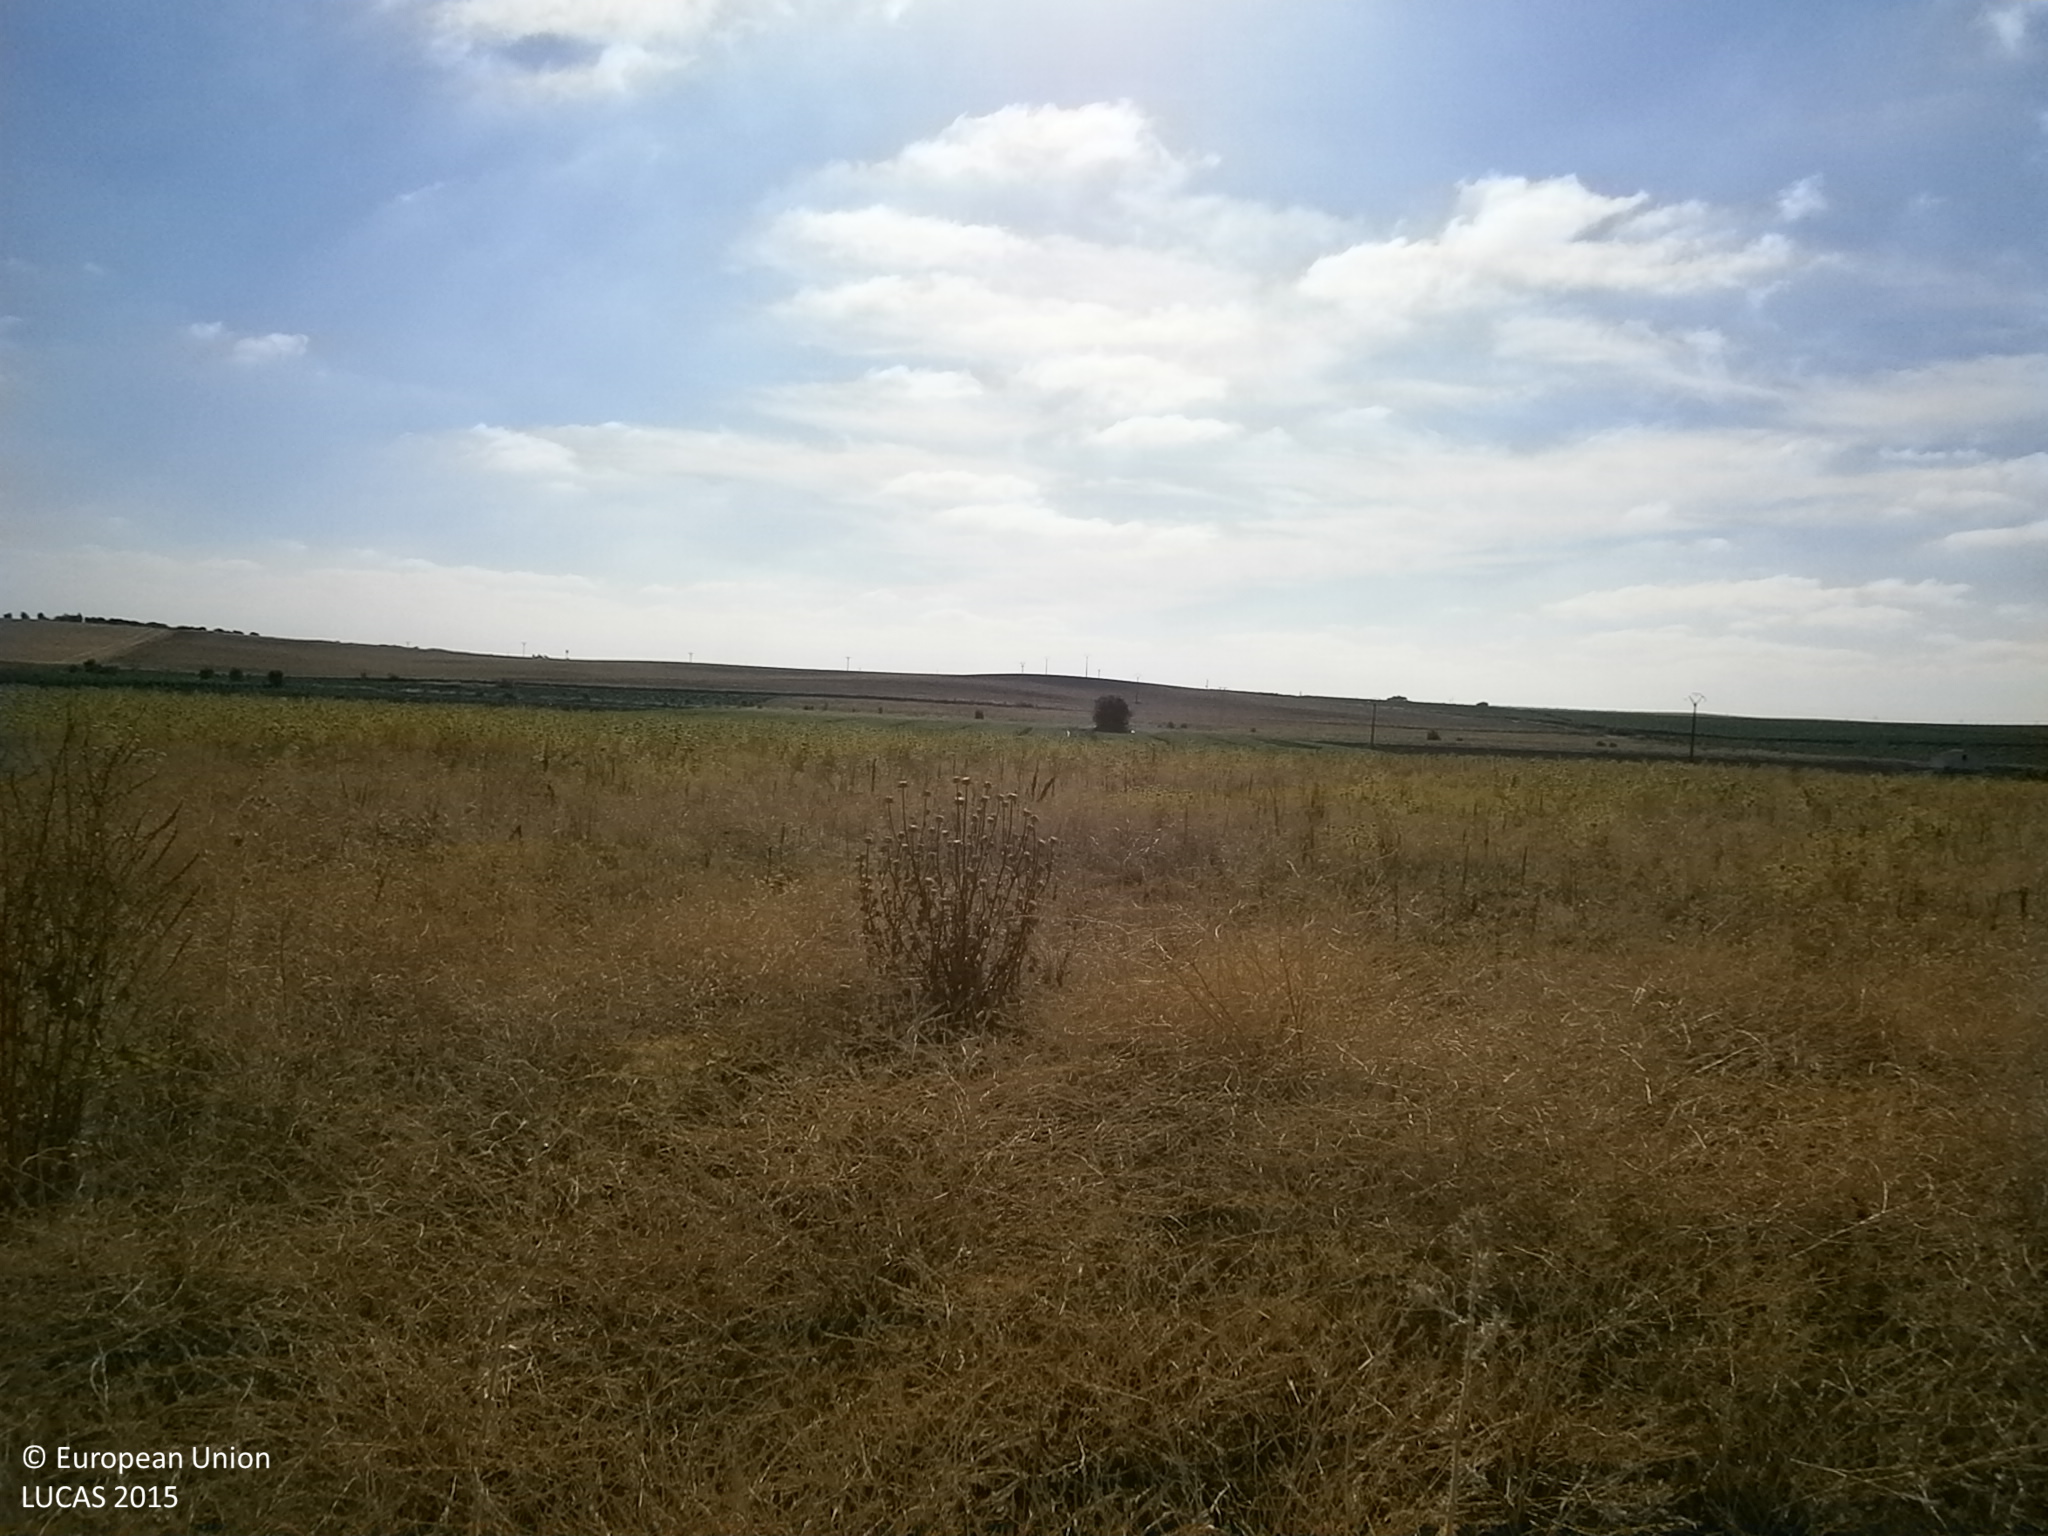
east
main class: Grassland
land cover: Spontaneously vegetated surfaces
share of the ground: > 75 %
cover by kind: herbaceous plants 95 %, unconsolidated bare surface 5 %
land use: Fallow land
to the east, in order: Spontaneously vegetated surfaces; Other bare soil
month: June
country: ES
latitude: 38.7073
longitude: -6.8417
